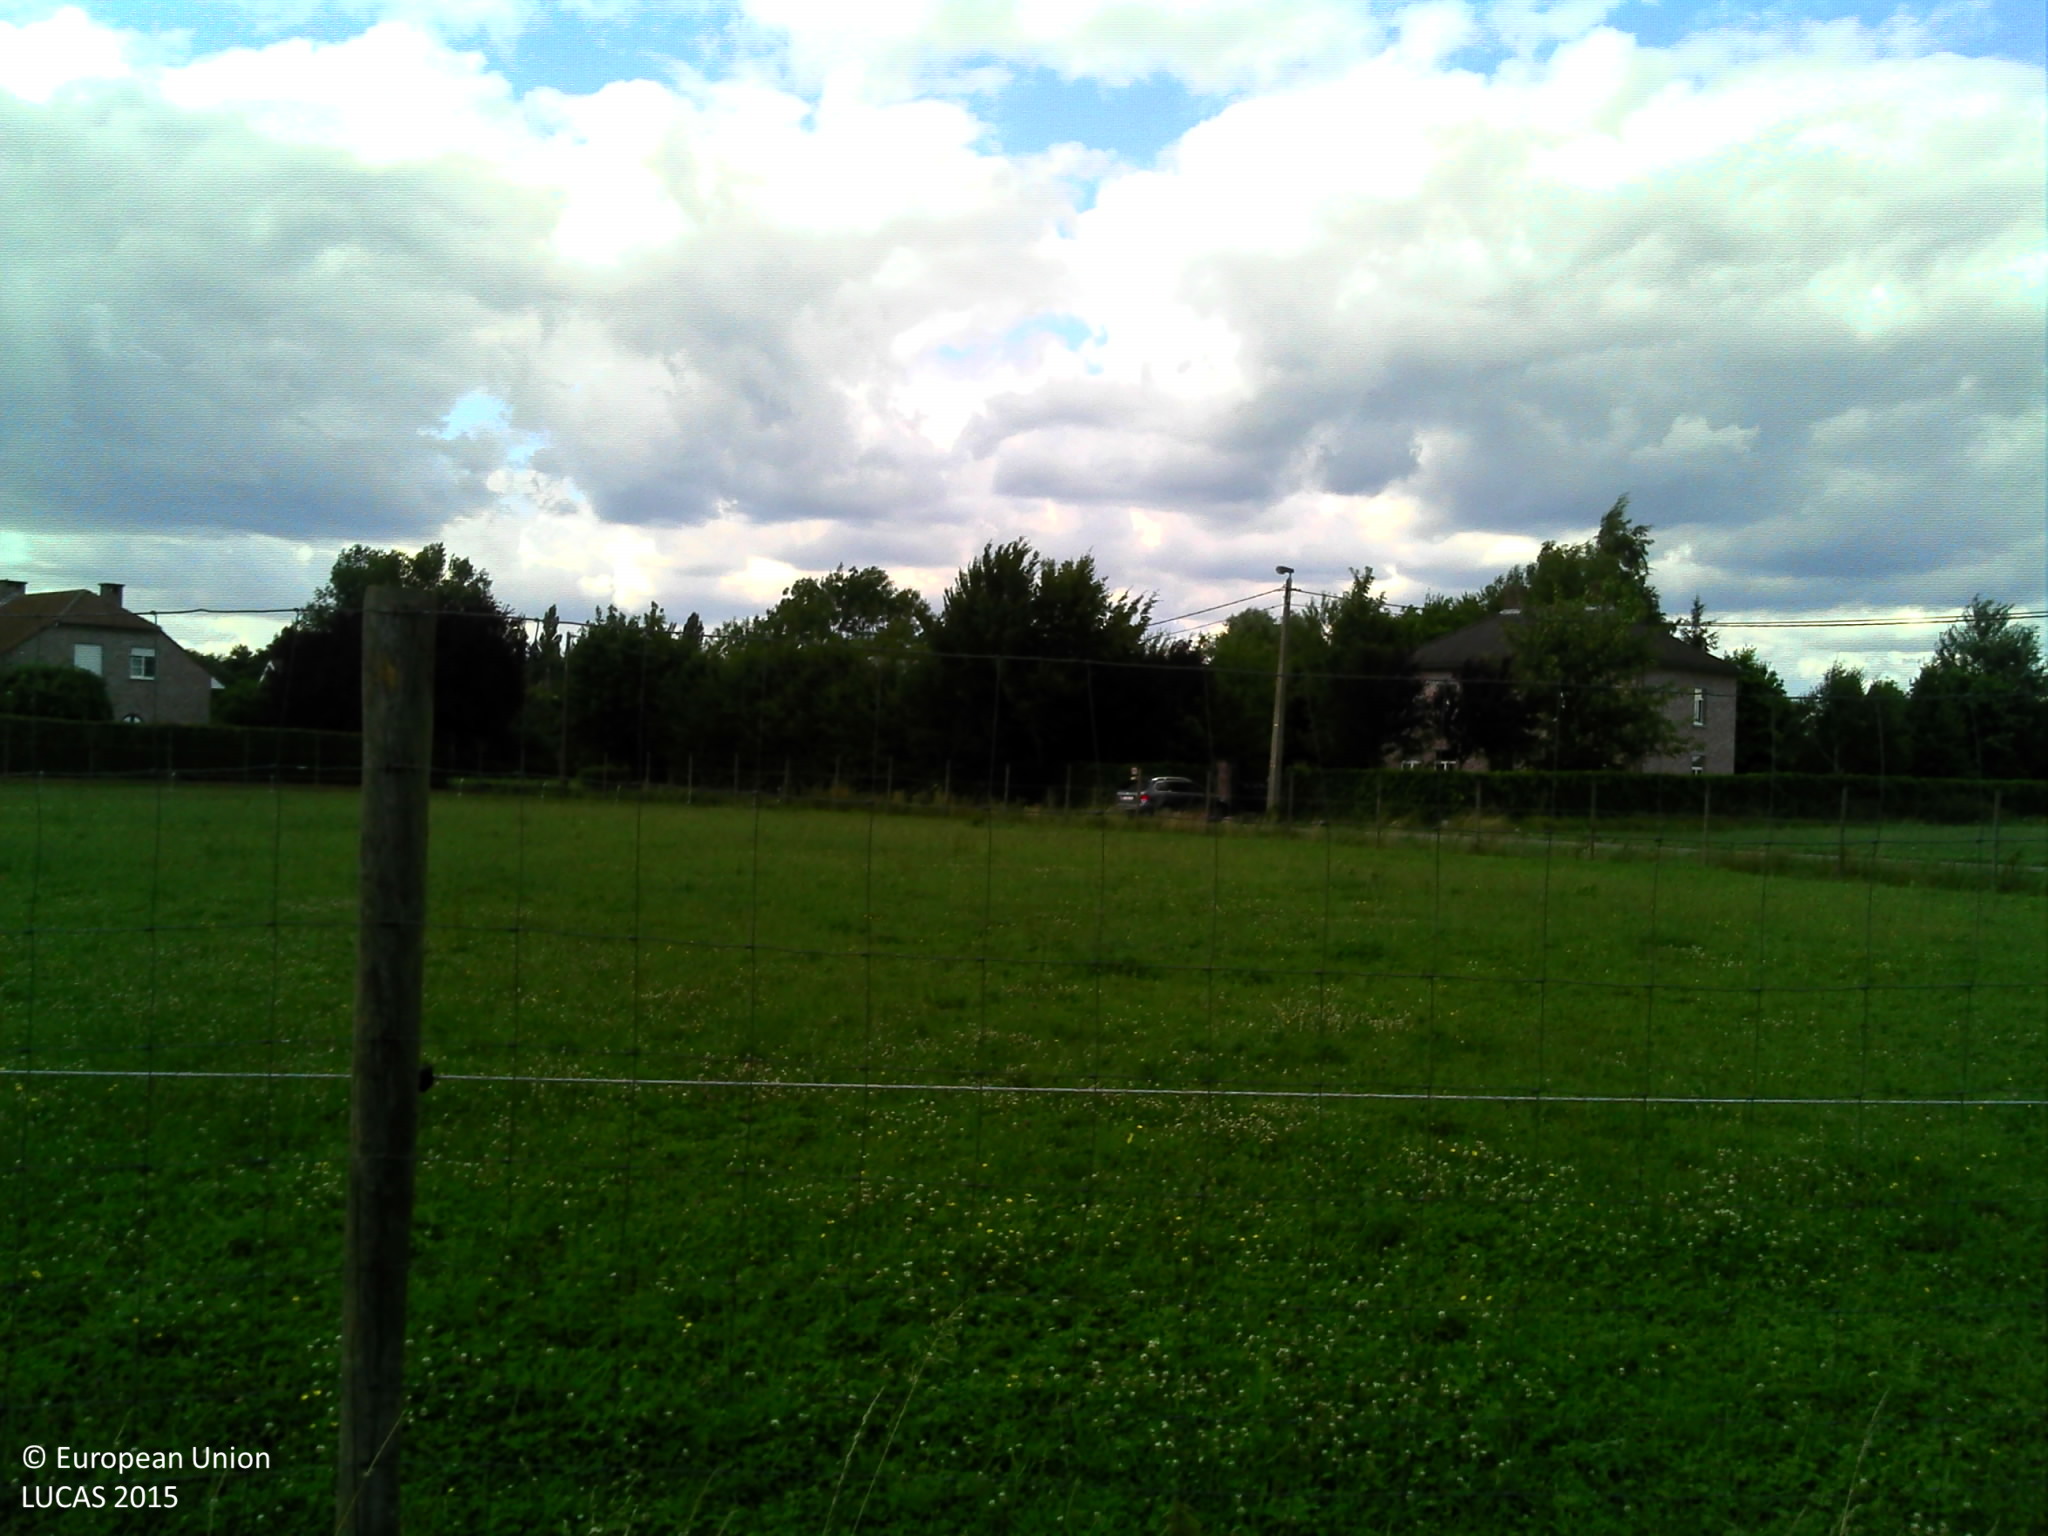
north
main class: Grassland
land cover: Grassland without tree/shrub cover
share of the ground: > 75 %
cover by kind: herbaceous plants 100 %
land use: Agriculture (excluding fallow land and kitchen gardens)
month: July
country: BE
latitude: 51.0981
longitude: 4.5266
